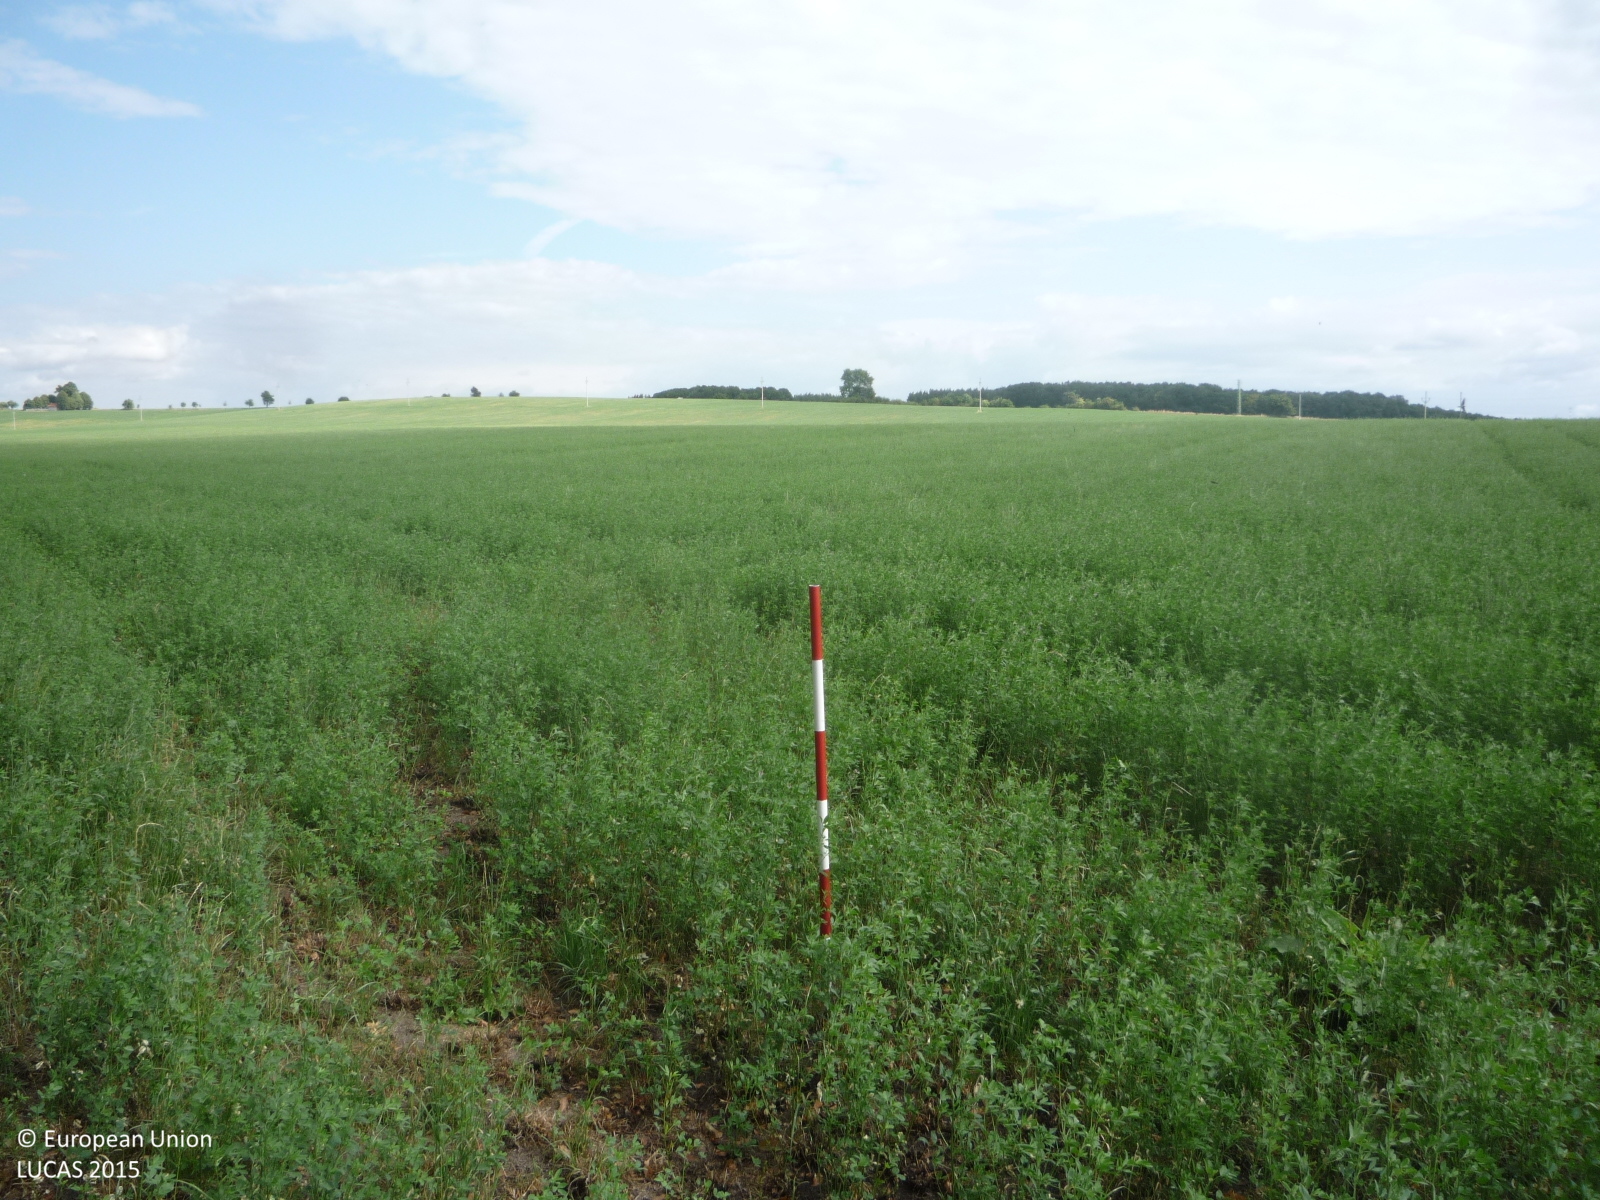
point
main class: Cropland
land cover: Lucerne
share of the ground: > 75 %
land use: Agriculture (excluding fallow land and kitchen gardens)
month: July
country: CZ
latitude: 50.3903
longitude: 15.1935
